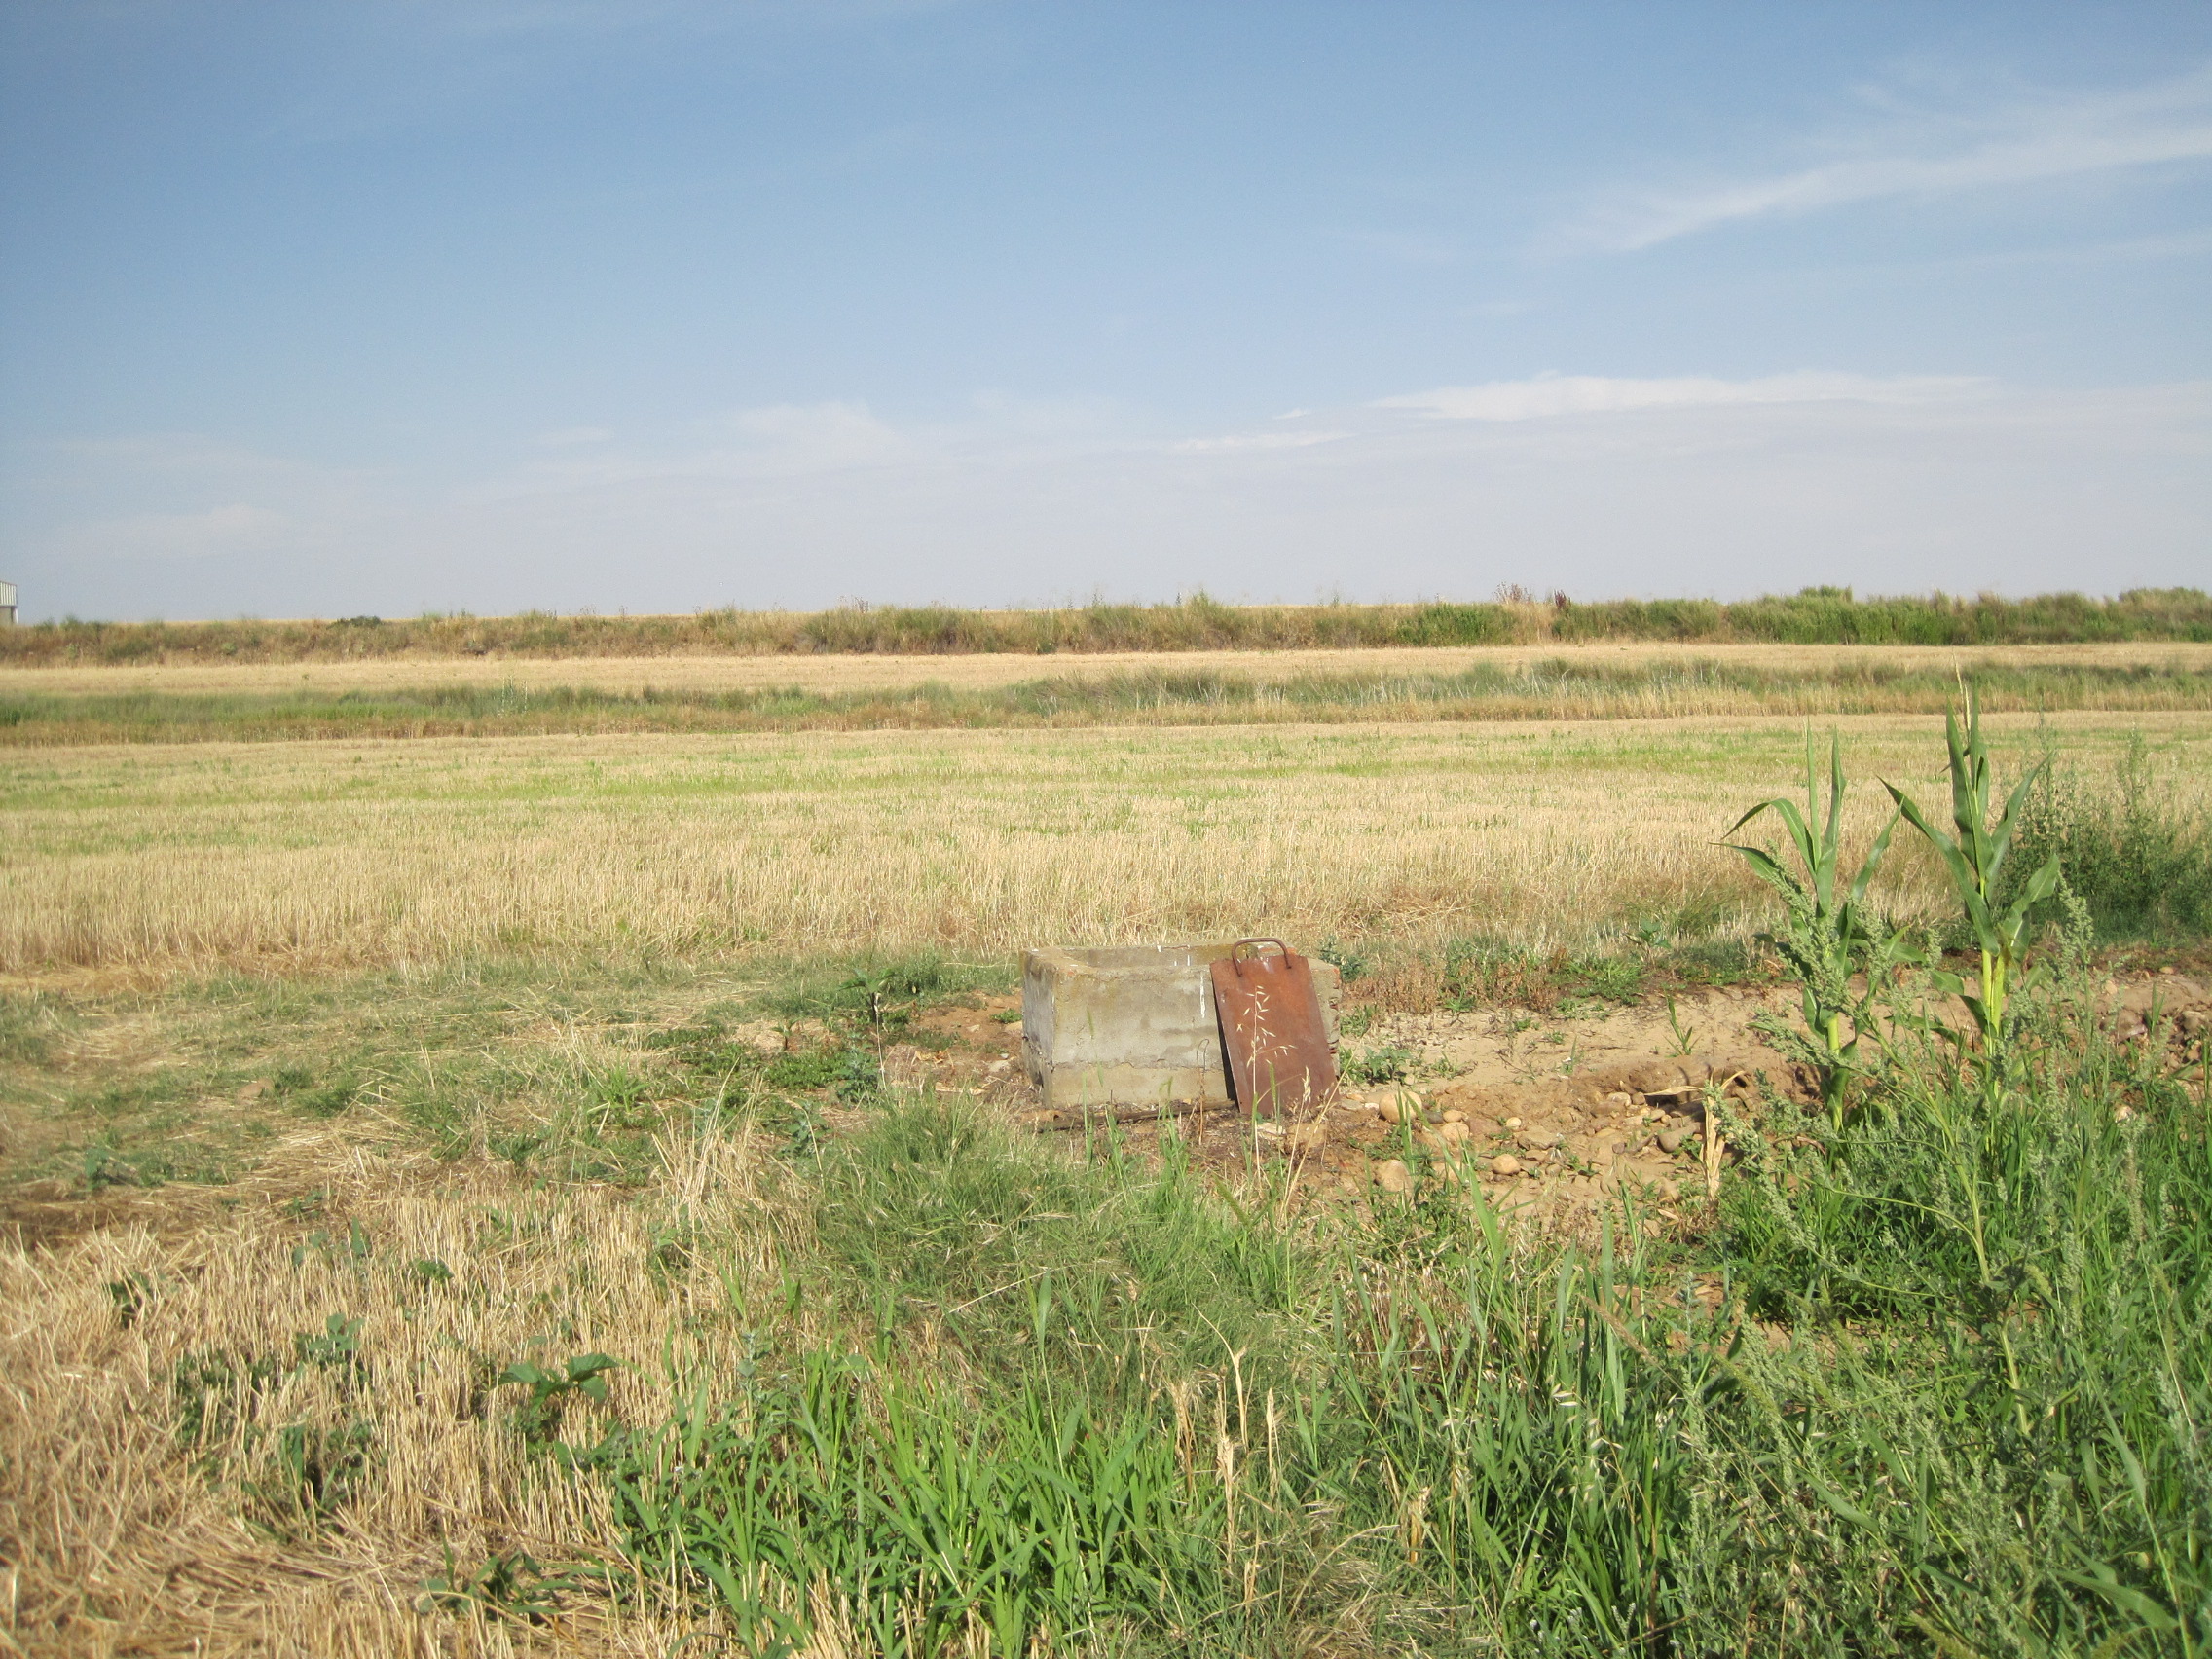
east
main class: Cropland
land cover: Common wheat
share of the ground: < 10 %
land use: Agriculture (excluding fallow land and kitchen gardens)
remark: Harvested field
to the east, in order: Common wheat; Grass margins; Ditches and canals; Grass margins; Tracks; Grass margins; Common wheat; Grass margins; Ditches and canals; Grass margins; Common wheat; Grass margins; Ditches and canals; Grass margins; Common wheat; Grass margins; Ditches and canals; Grass margins; Rye
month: July
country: ES
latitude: 41.7228
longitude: -5.5318
